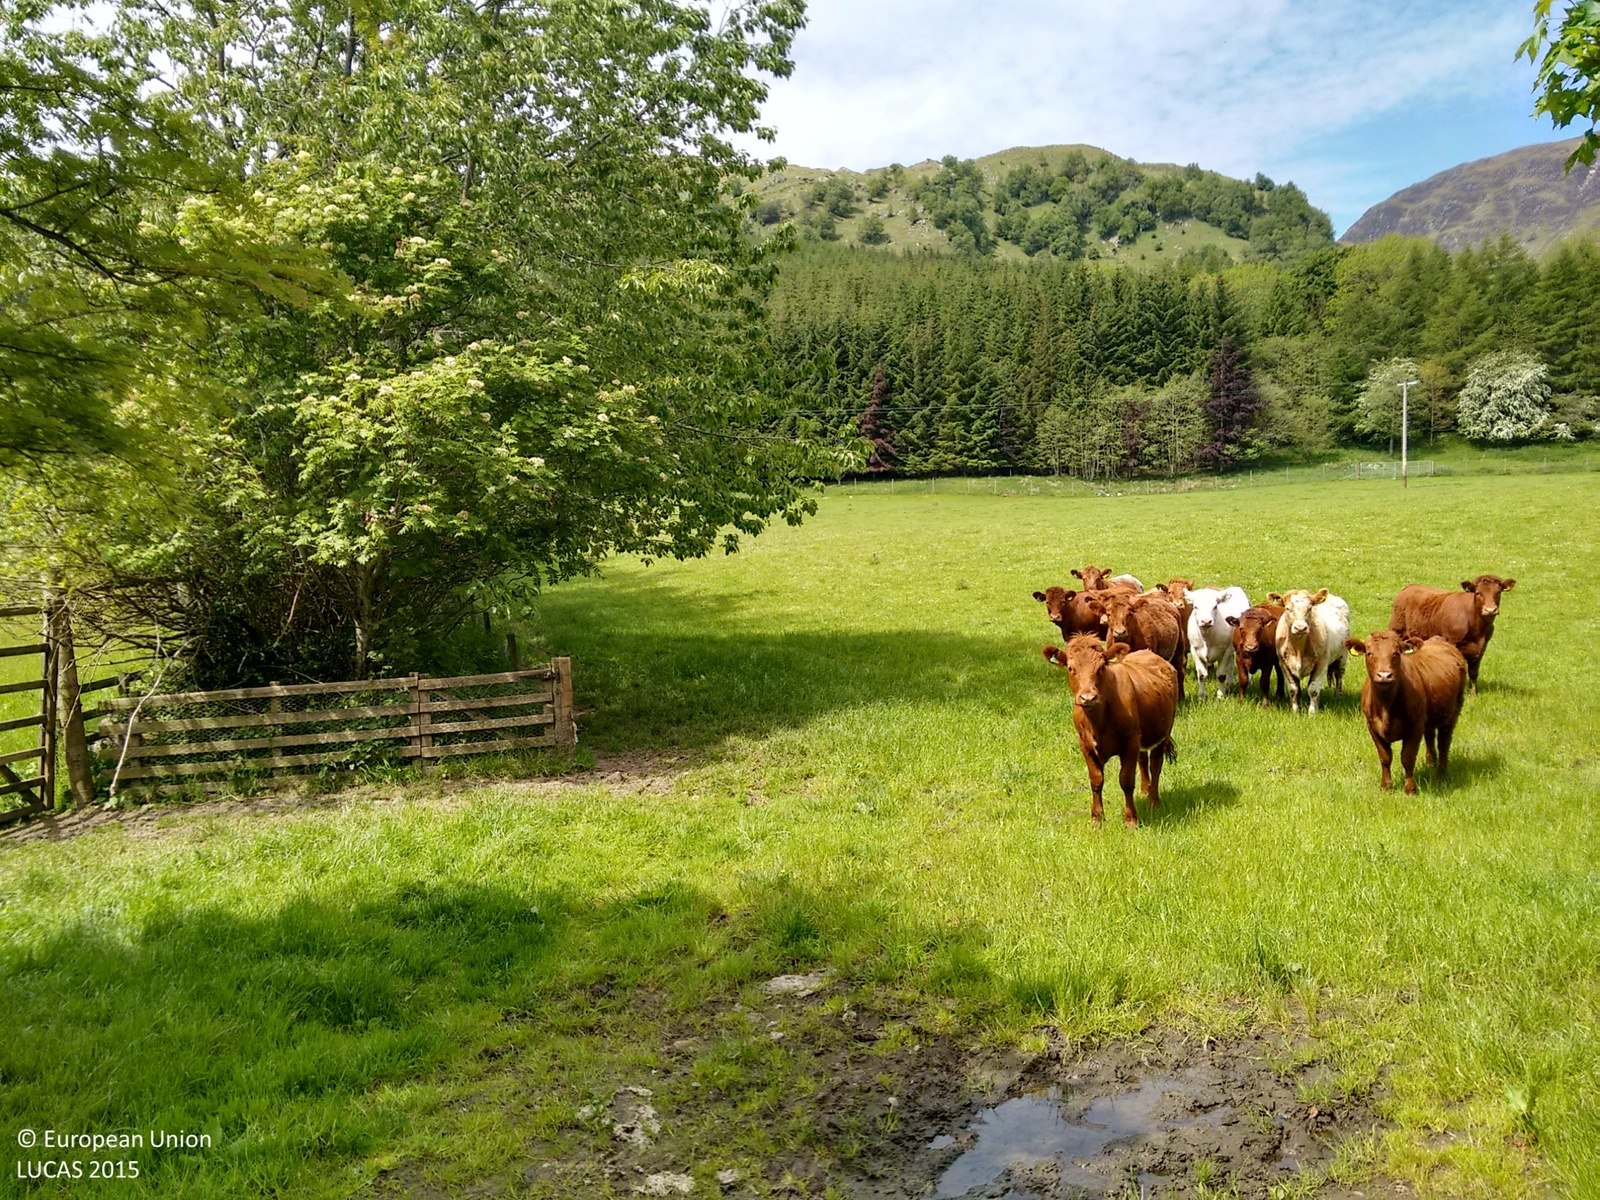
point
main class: Grassland
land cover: Grassland without tree/shrub cover
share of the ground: > 75 %
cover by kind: herbaceous plants 100 %
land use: Agriculture (excluding fallow land and kitchen gardens)
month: June
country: GB
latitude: 56.5951
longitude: -4.0761
